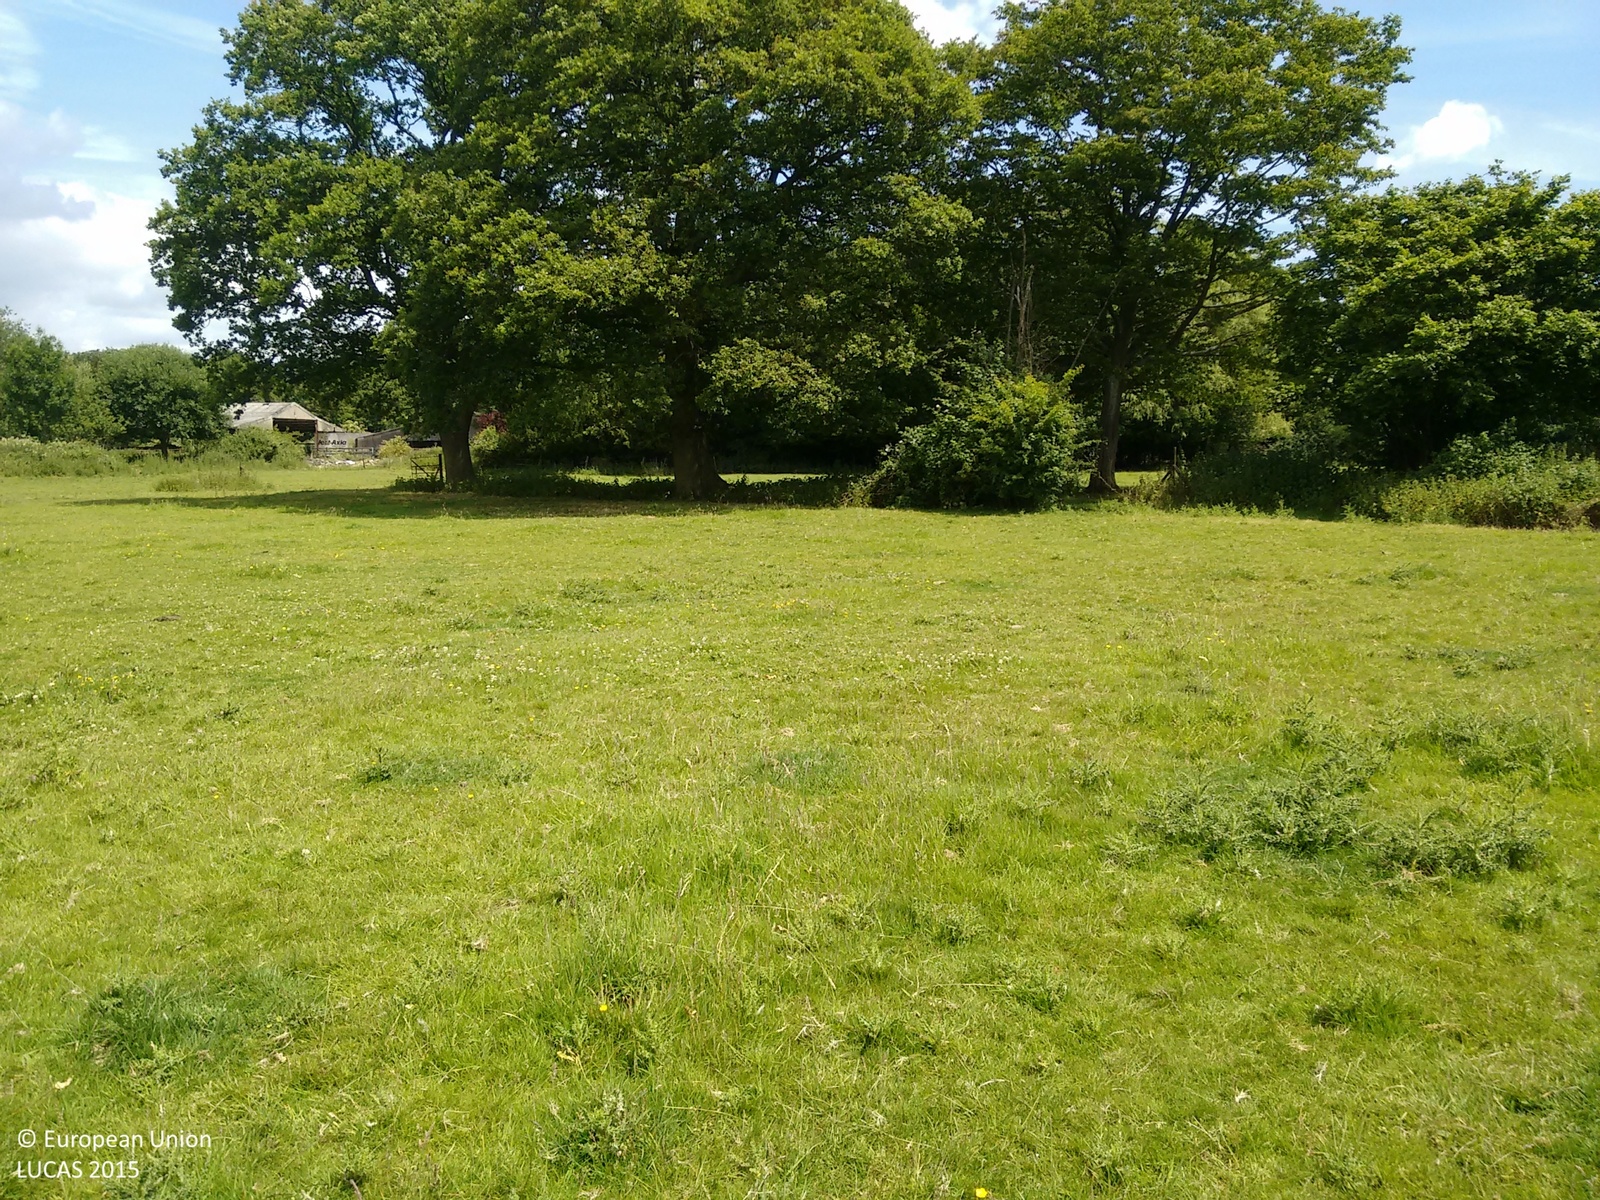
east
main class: Grassland
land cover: Grassland without tree/shrub cover
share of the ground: > 75 %
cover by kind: herbaceous plants 100 %
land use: Agriculture (excluding fallow land and kitchen gardens)
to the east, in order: Grassland without tree/shrub cover; Lines of trees; Grassland without tree/shrub cover; Fences; Broadleaved woodland; Grassland without tree/shrub cover; Artificial constructions in urban areas; Broadleaved woodland; Paved roads, cycling and walking lanes; Electric lines; Grass margins; Managed hedges; Grassland without tree/shrub cover
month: June
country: GB
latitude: 51.1397
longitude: -0.1971
